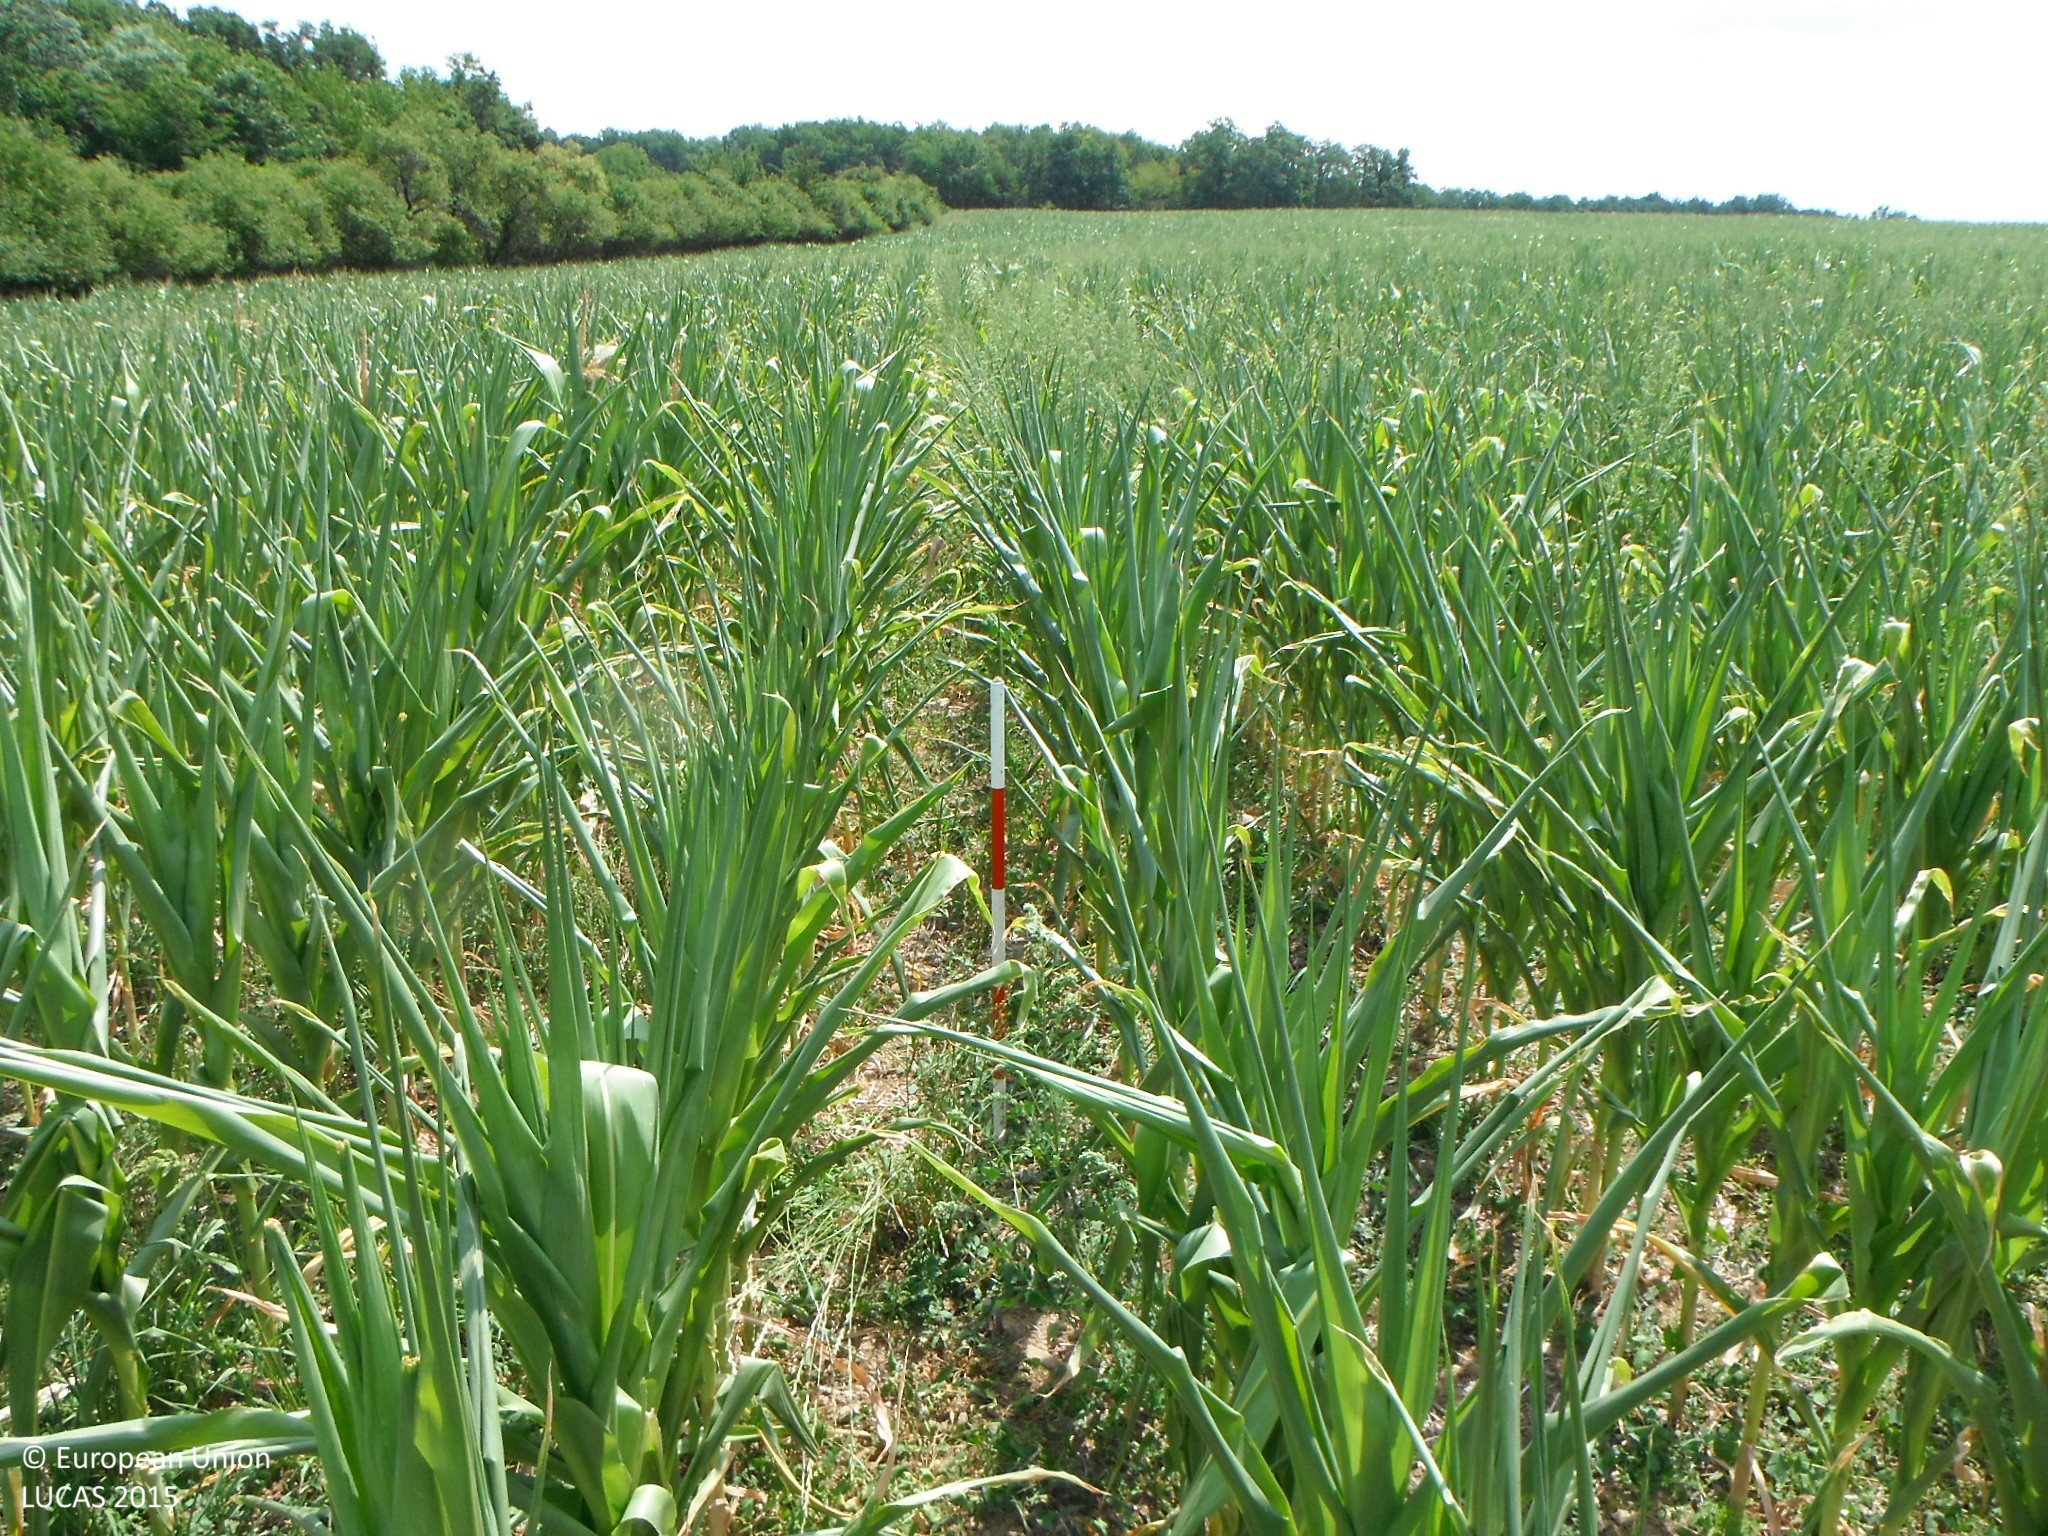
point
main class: Cropland
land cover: Maize
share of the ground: > 75 %
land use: Agriculture (excluding fallow land and kitchen gardens)
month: July
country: SK
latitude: 48.2975
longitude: 19.1201
